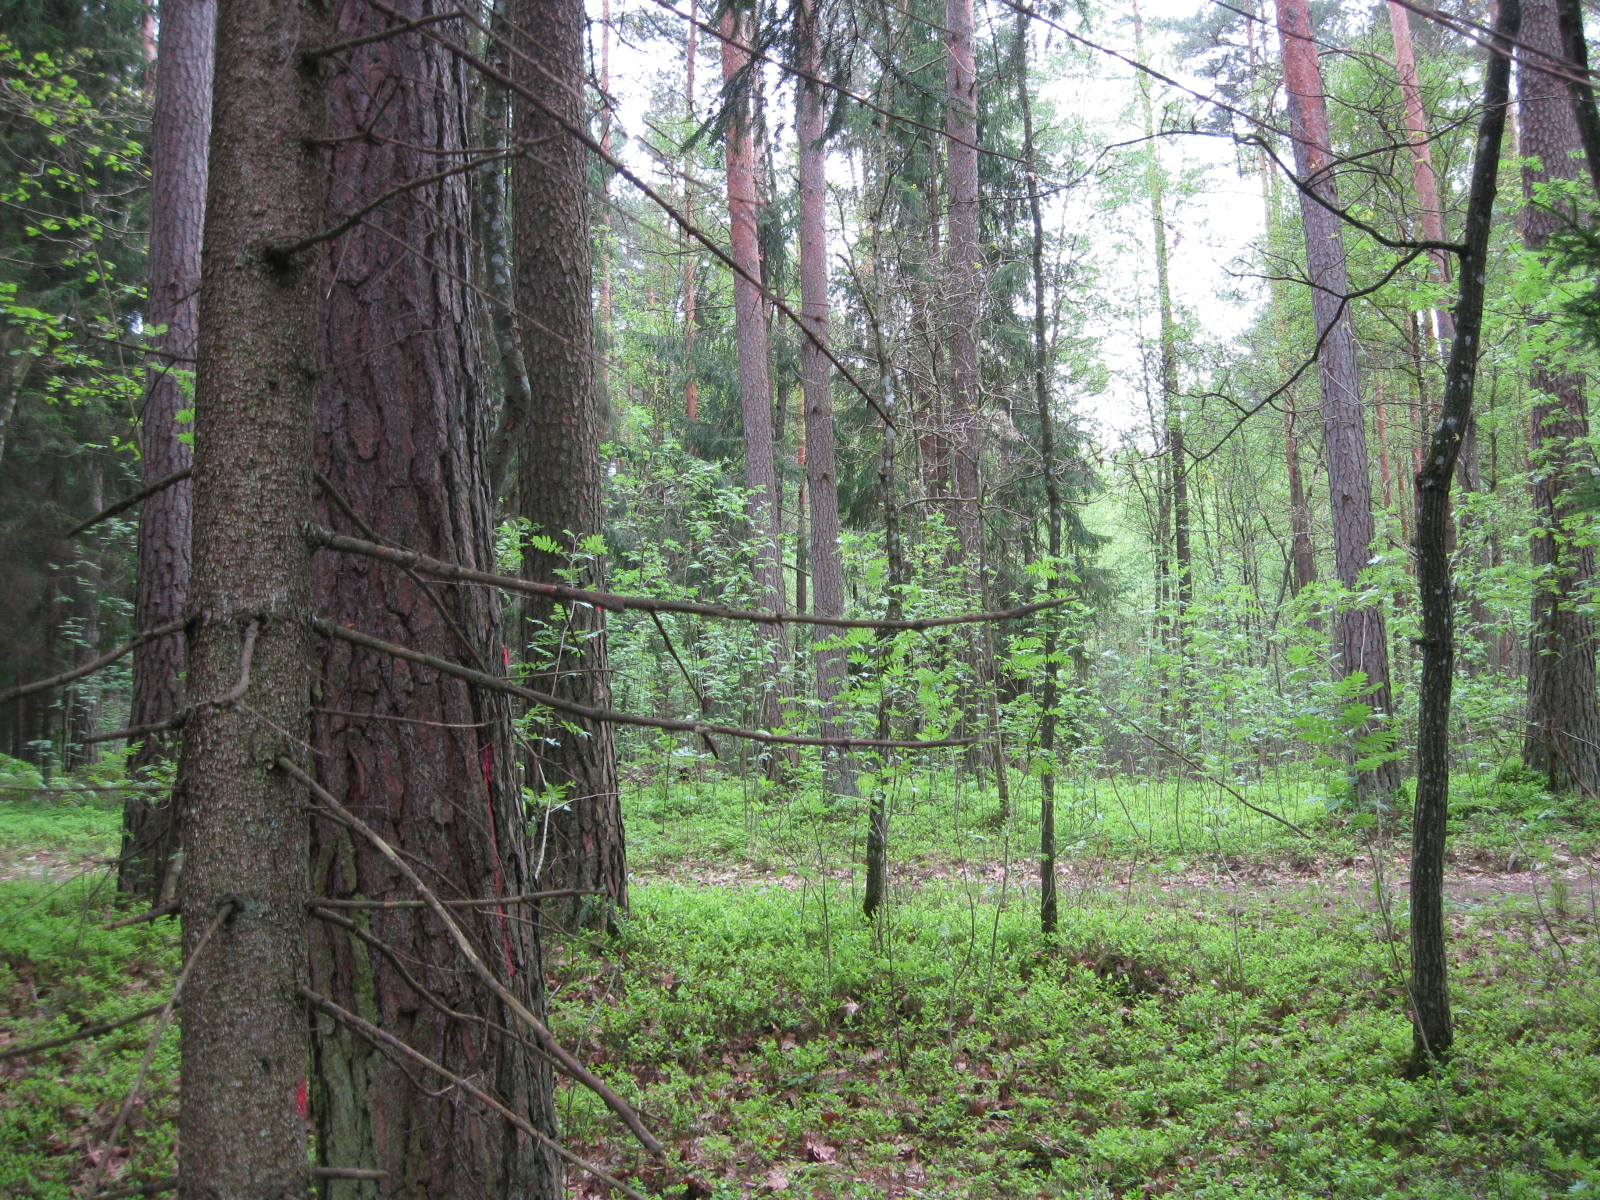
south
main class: Woodland
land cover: Other mixed woodland
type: hemiboreal forest and nemoral coniferous forest and mixed broadleaved-coniferous forest
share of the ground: > 75 %
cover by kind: coniferous forest trees 45 %, broadleaved forest trees 40 %, shrubs 5 %, herbaceous plants 5 %, lichens and mosses 5 %
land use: Forestry
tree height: > 5 m
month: May
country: LT
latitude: 55.9588
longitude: 24.3671
